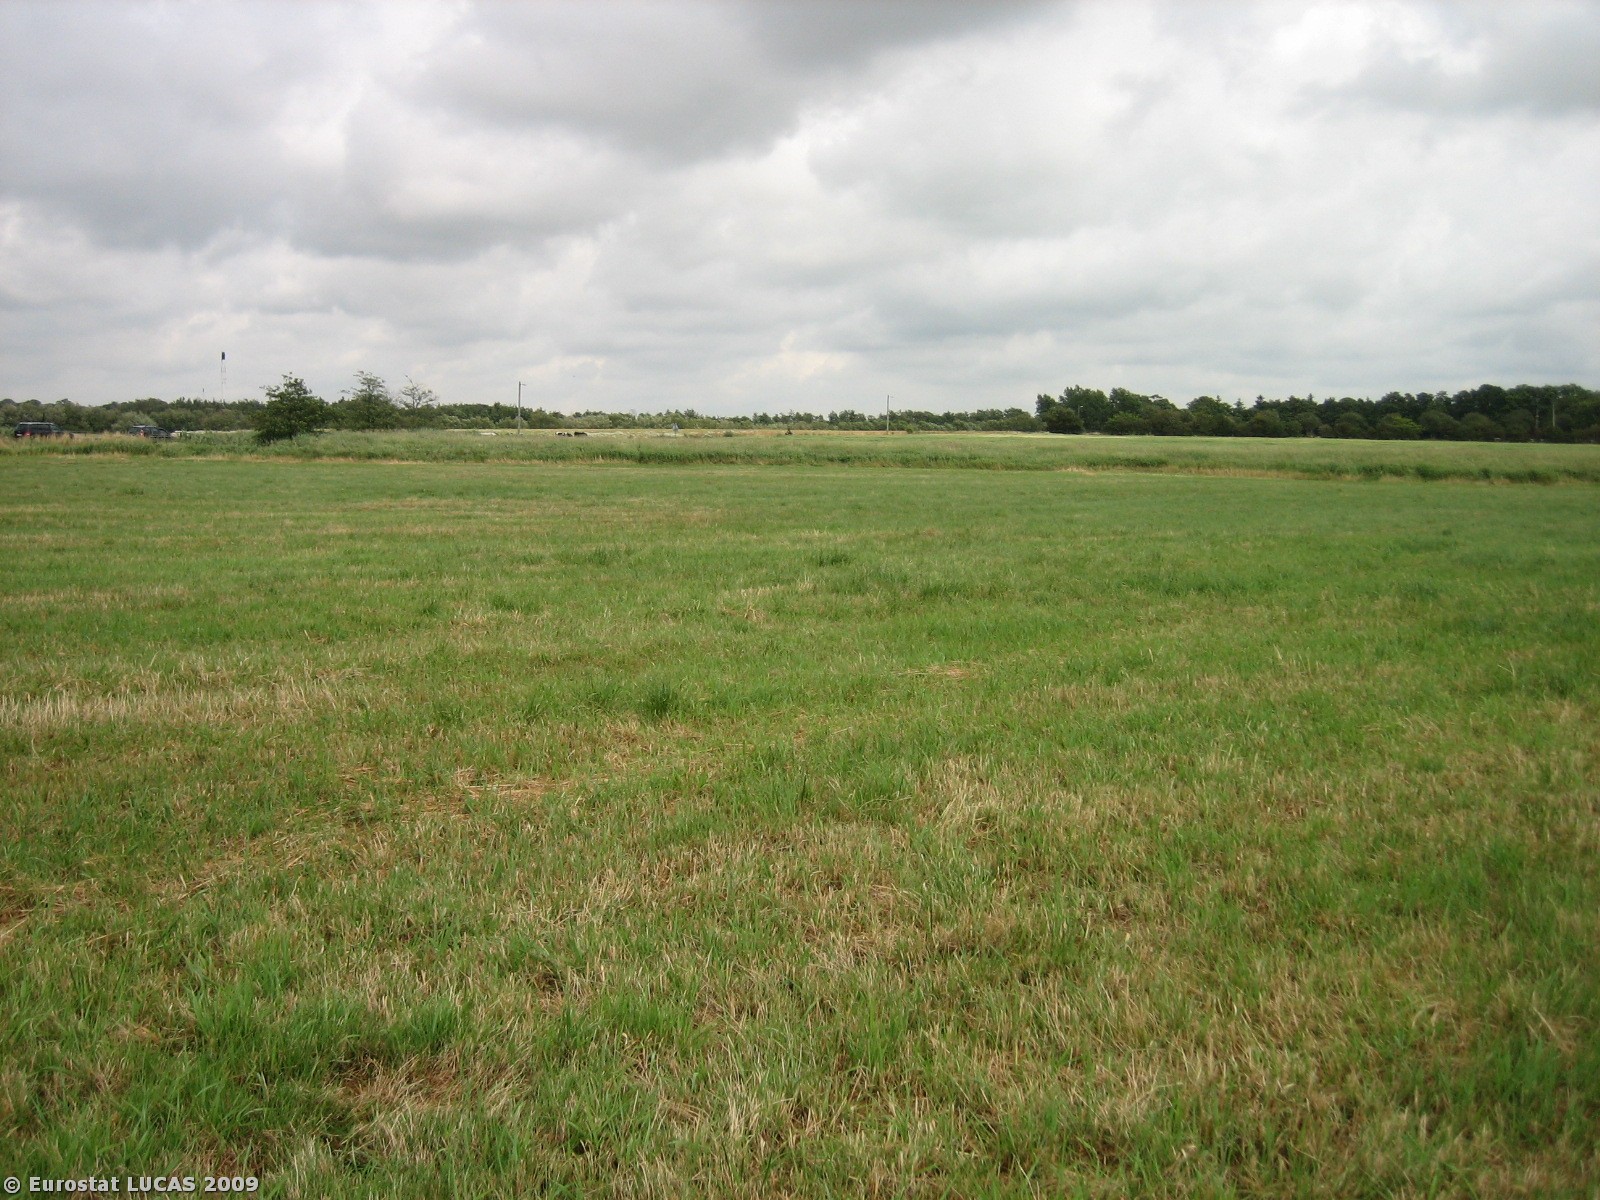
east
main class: Grassland
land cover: Grassland without tree/shrub cover
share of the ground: > 75 %
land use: Agriculture (excluding fallow land and kitchen gardens)
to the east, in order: Grassland without tree/shrub cover; Rivers and streams; Grassland without tree/shrub cover; Barley; Grassland without tree/shrub cover; Grass margins; Paved roads, cycling and walking lanes; Grass margins
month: July
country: DK
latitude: 55.4606
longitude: 8.5621
